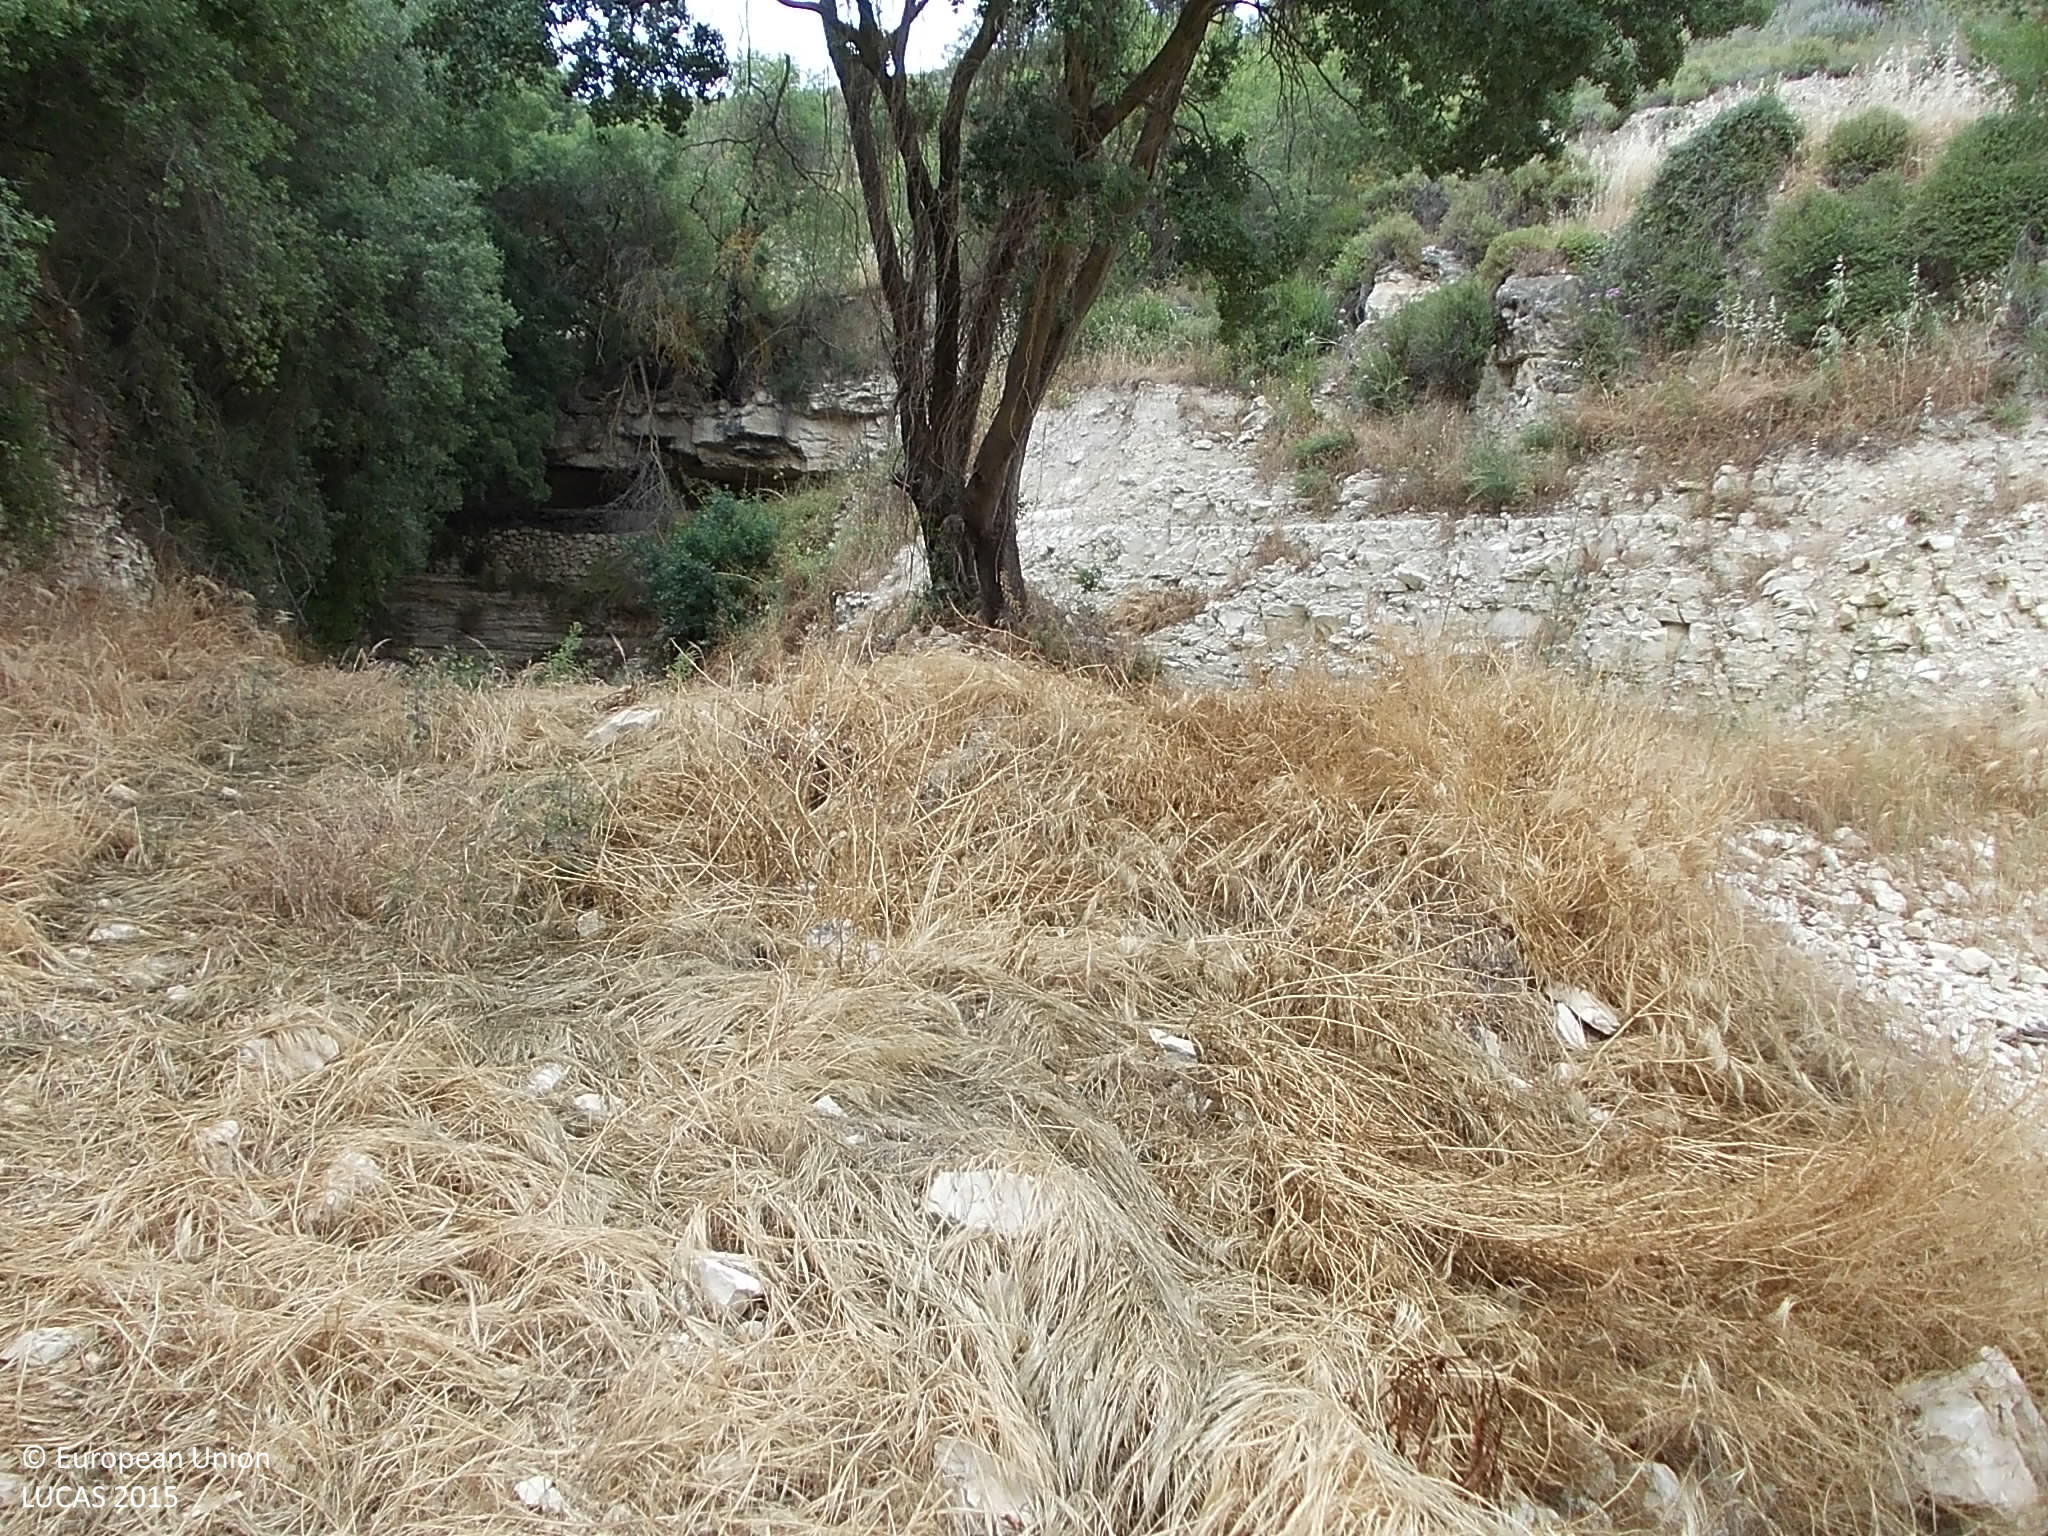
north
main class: Woodland
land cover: Broadleaved woodland
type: broadleaved evergreen forest
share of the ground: 10 - 25 %
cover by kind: shrubs 65 %, broadleaved forest trees 15 %, herbaceous plants 10 %, unconsolidated bare surface 10 %
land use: Semi-natural and natural areas not in use
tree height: > 5 m
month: May
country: CY
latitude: 34.8252
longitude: 32.8039
